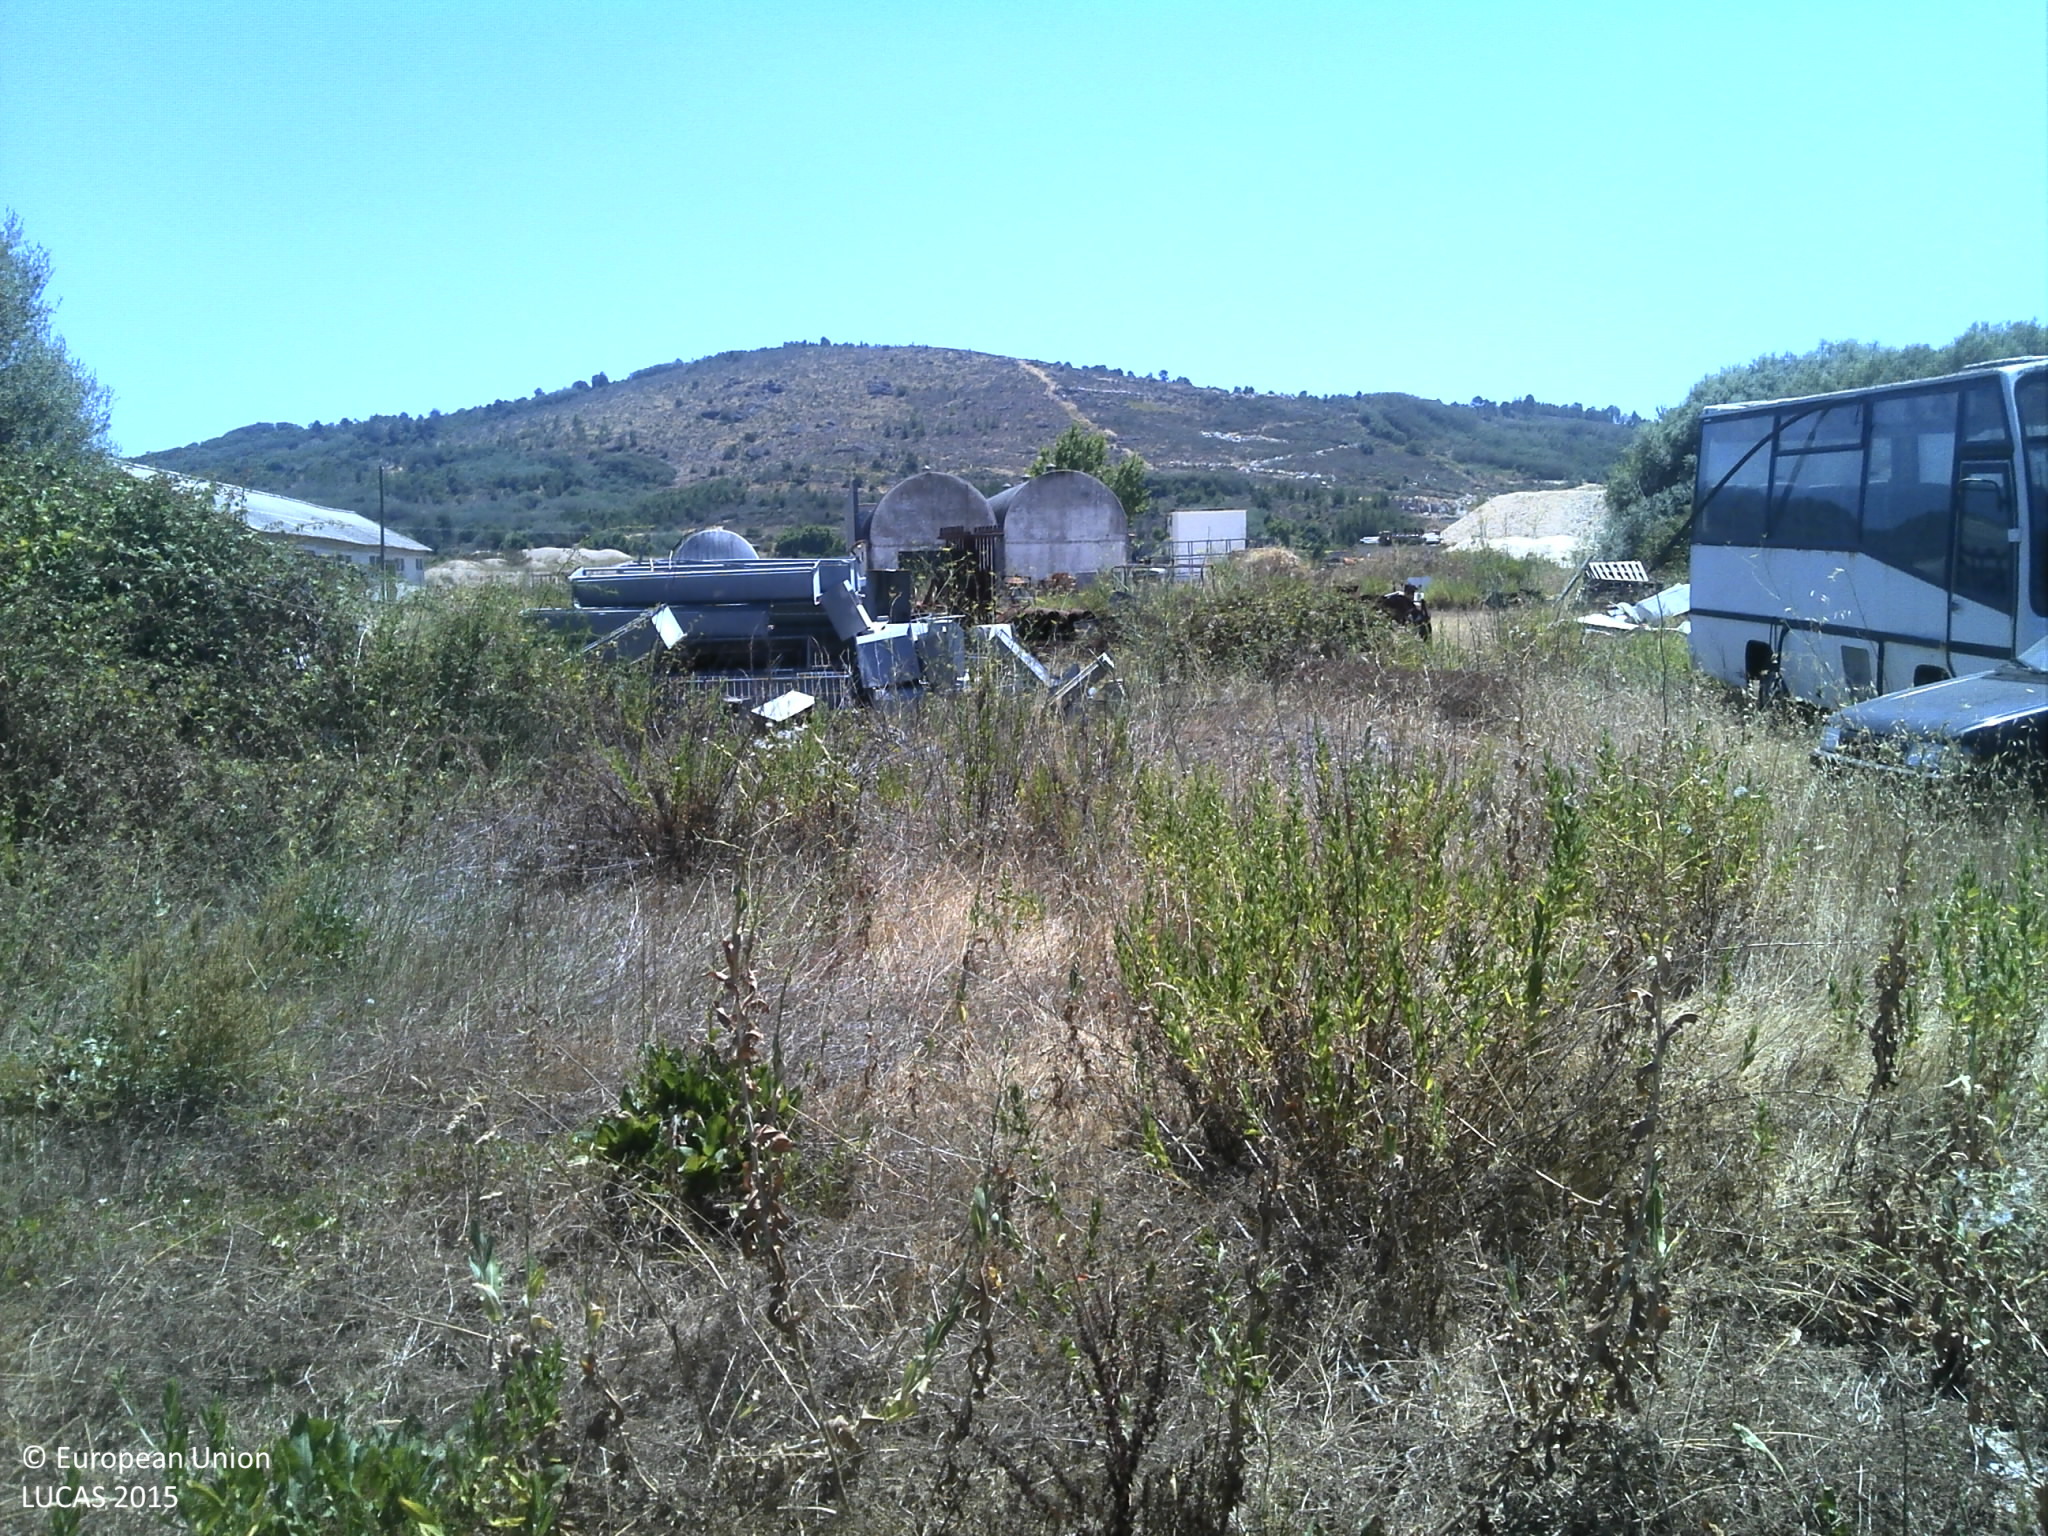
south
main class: Shrubland
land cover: Shrubland without tree cover
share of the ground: > 75 %
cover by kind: shrubs 80 %, herbaceous plants 10 %, unconsolidated bare surface 5 %
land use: Abandoned areas
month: July
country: PT
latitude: 40.4066
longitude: -7.3447
